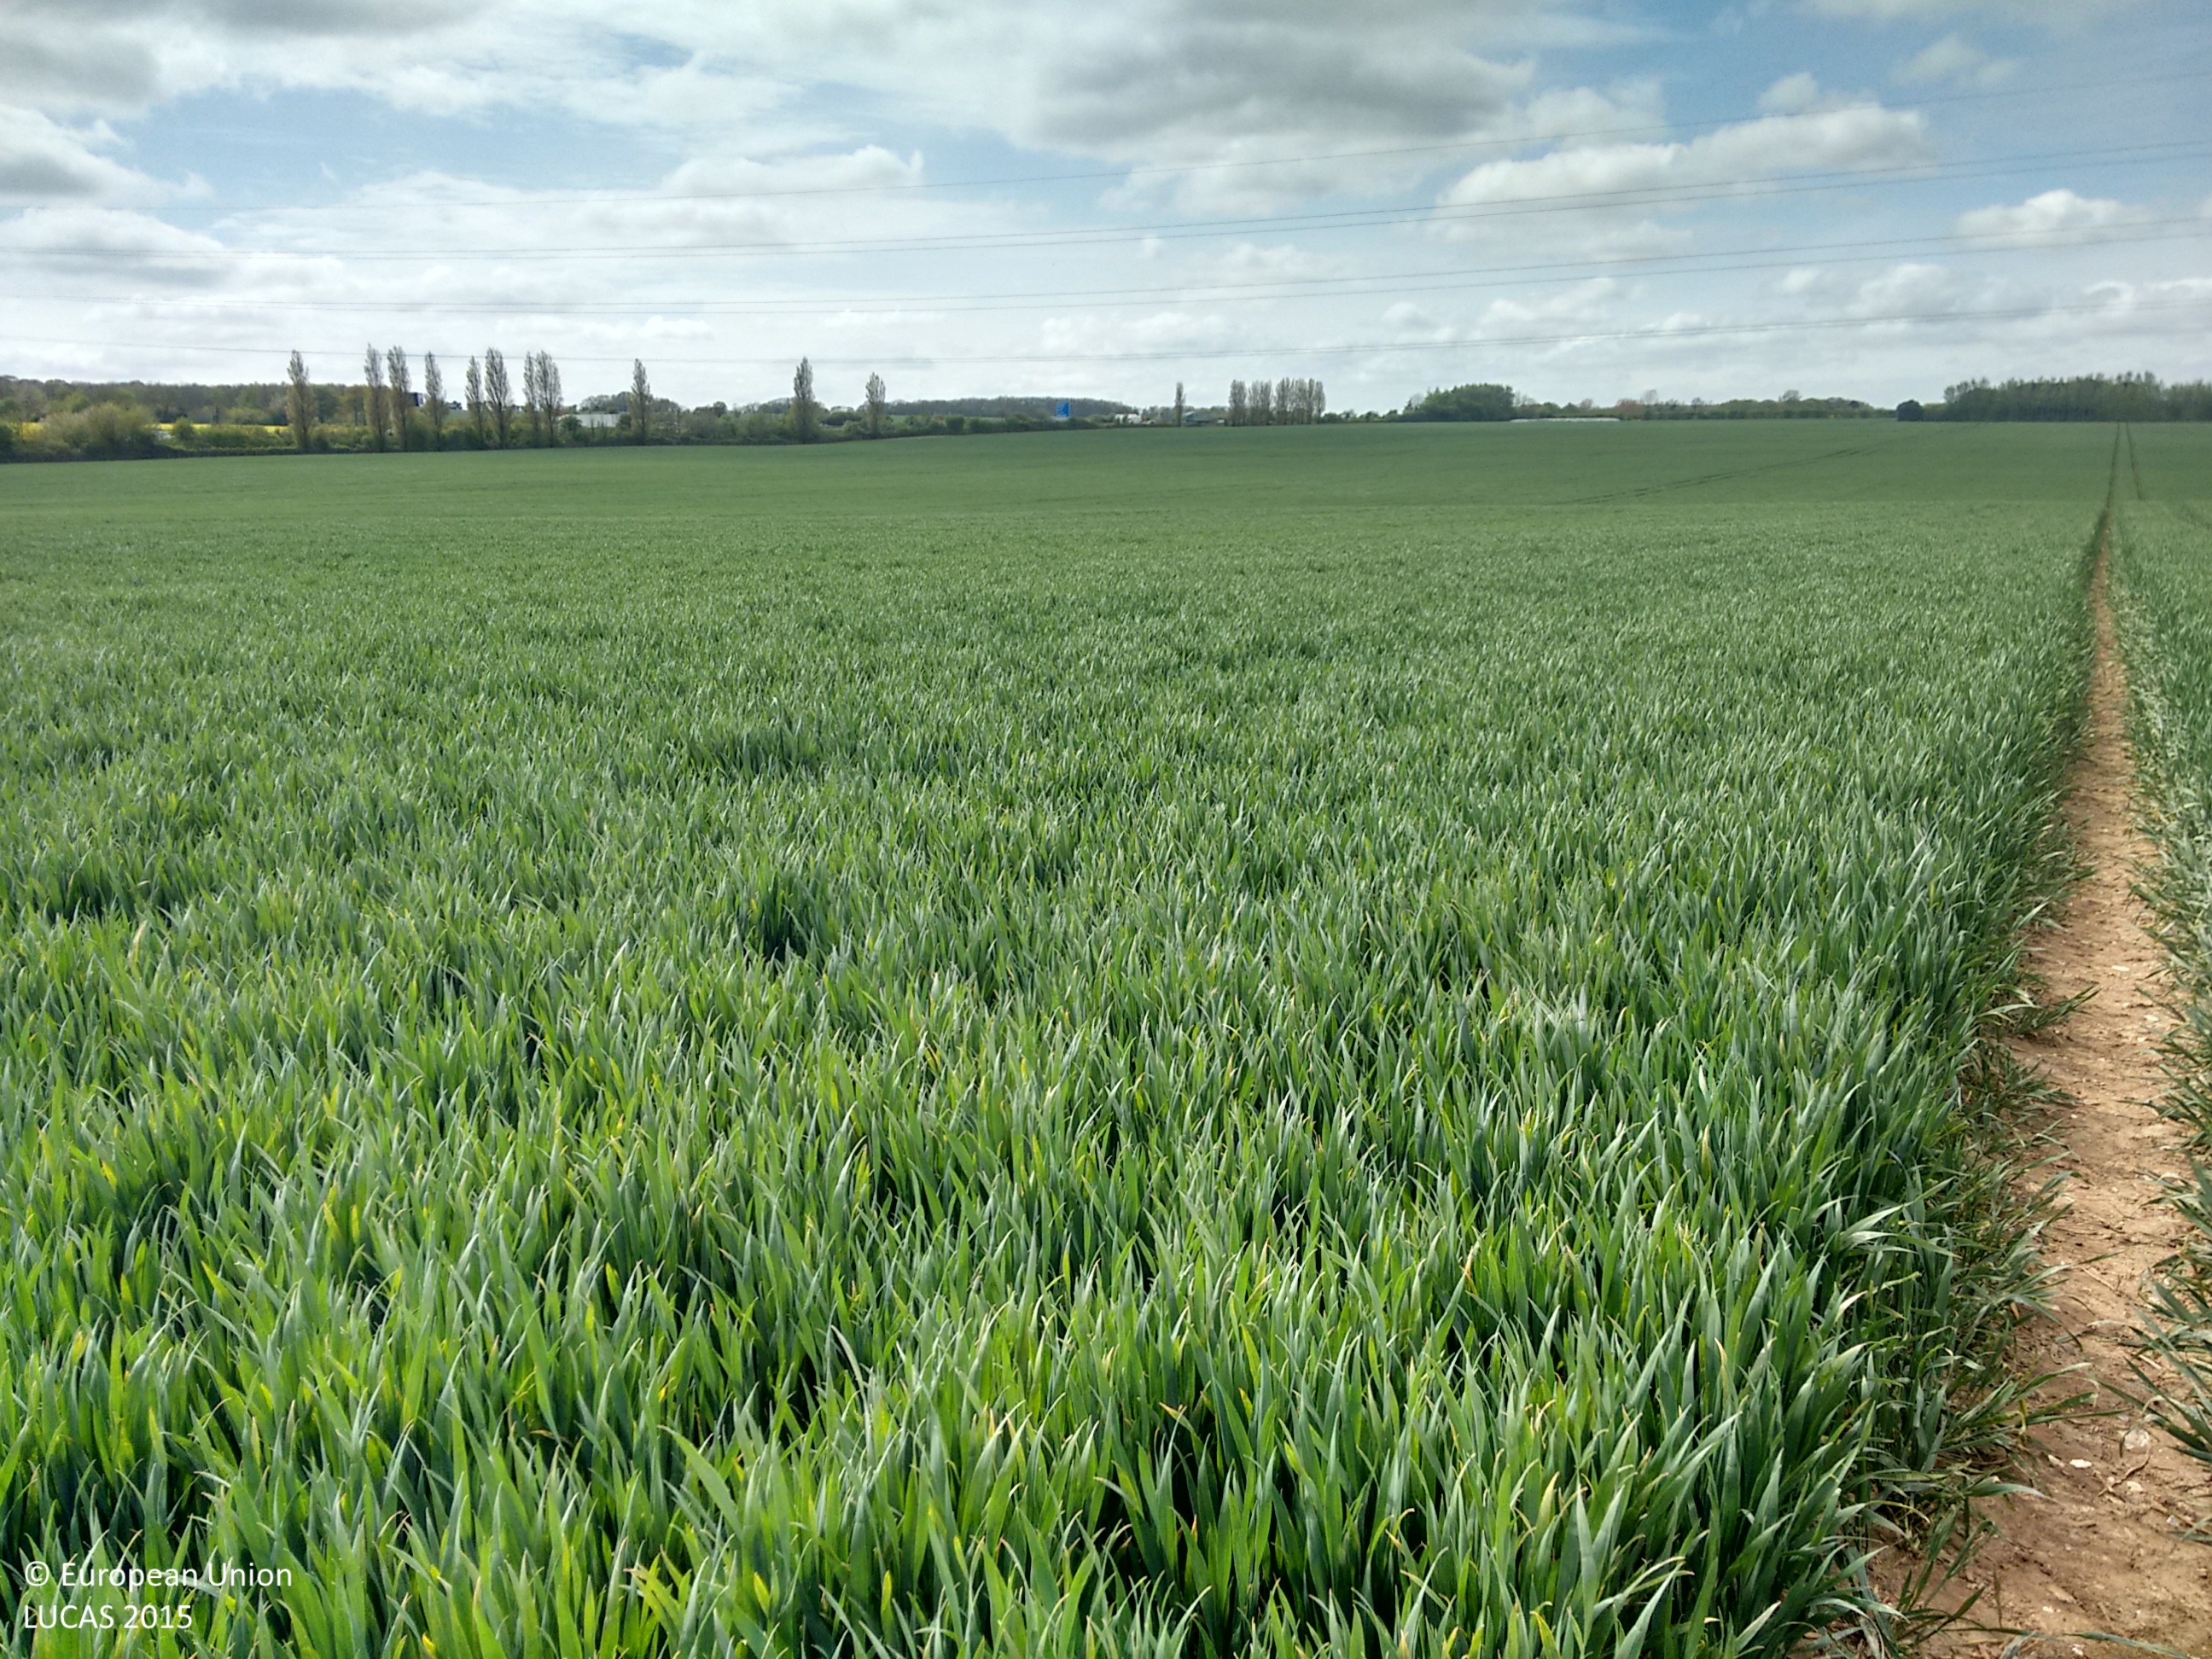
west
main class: Cropland
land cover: Common wheat
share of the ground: > 75 %
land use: Agriculture (excluding fallow land and kitchen gardens)
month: May
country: GB
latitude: 51.3231
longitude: 0.6895
